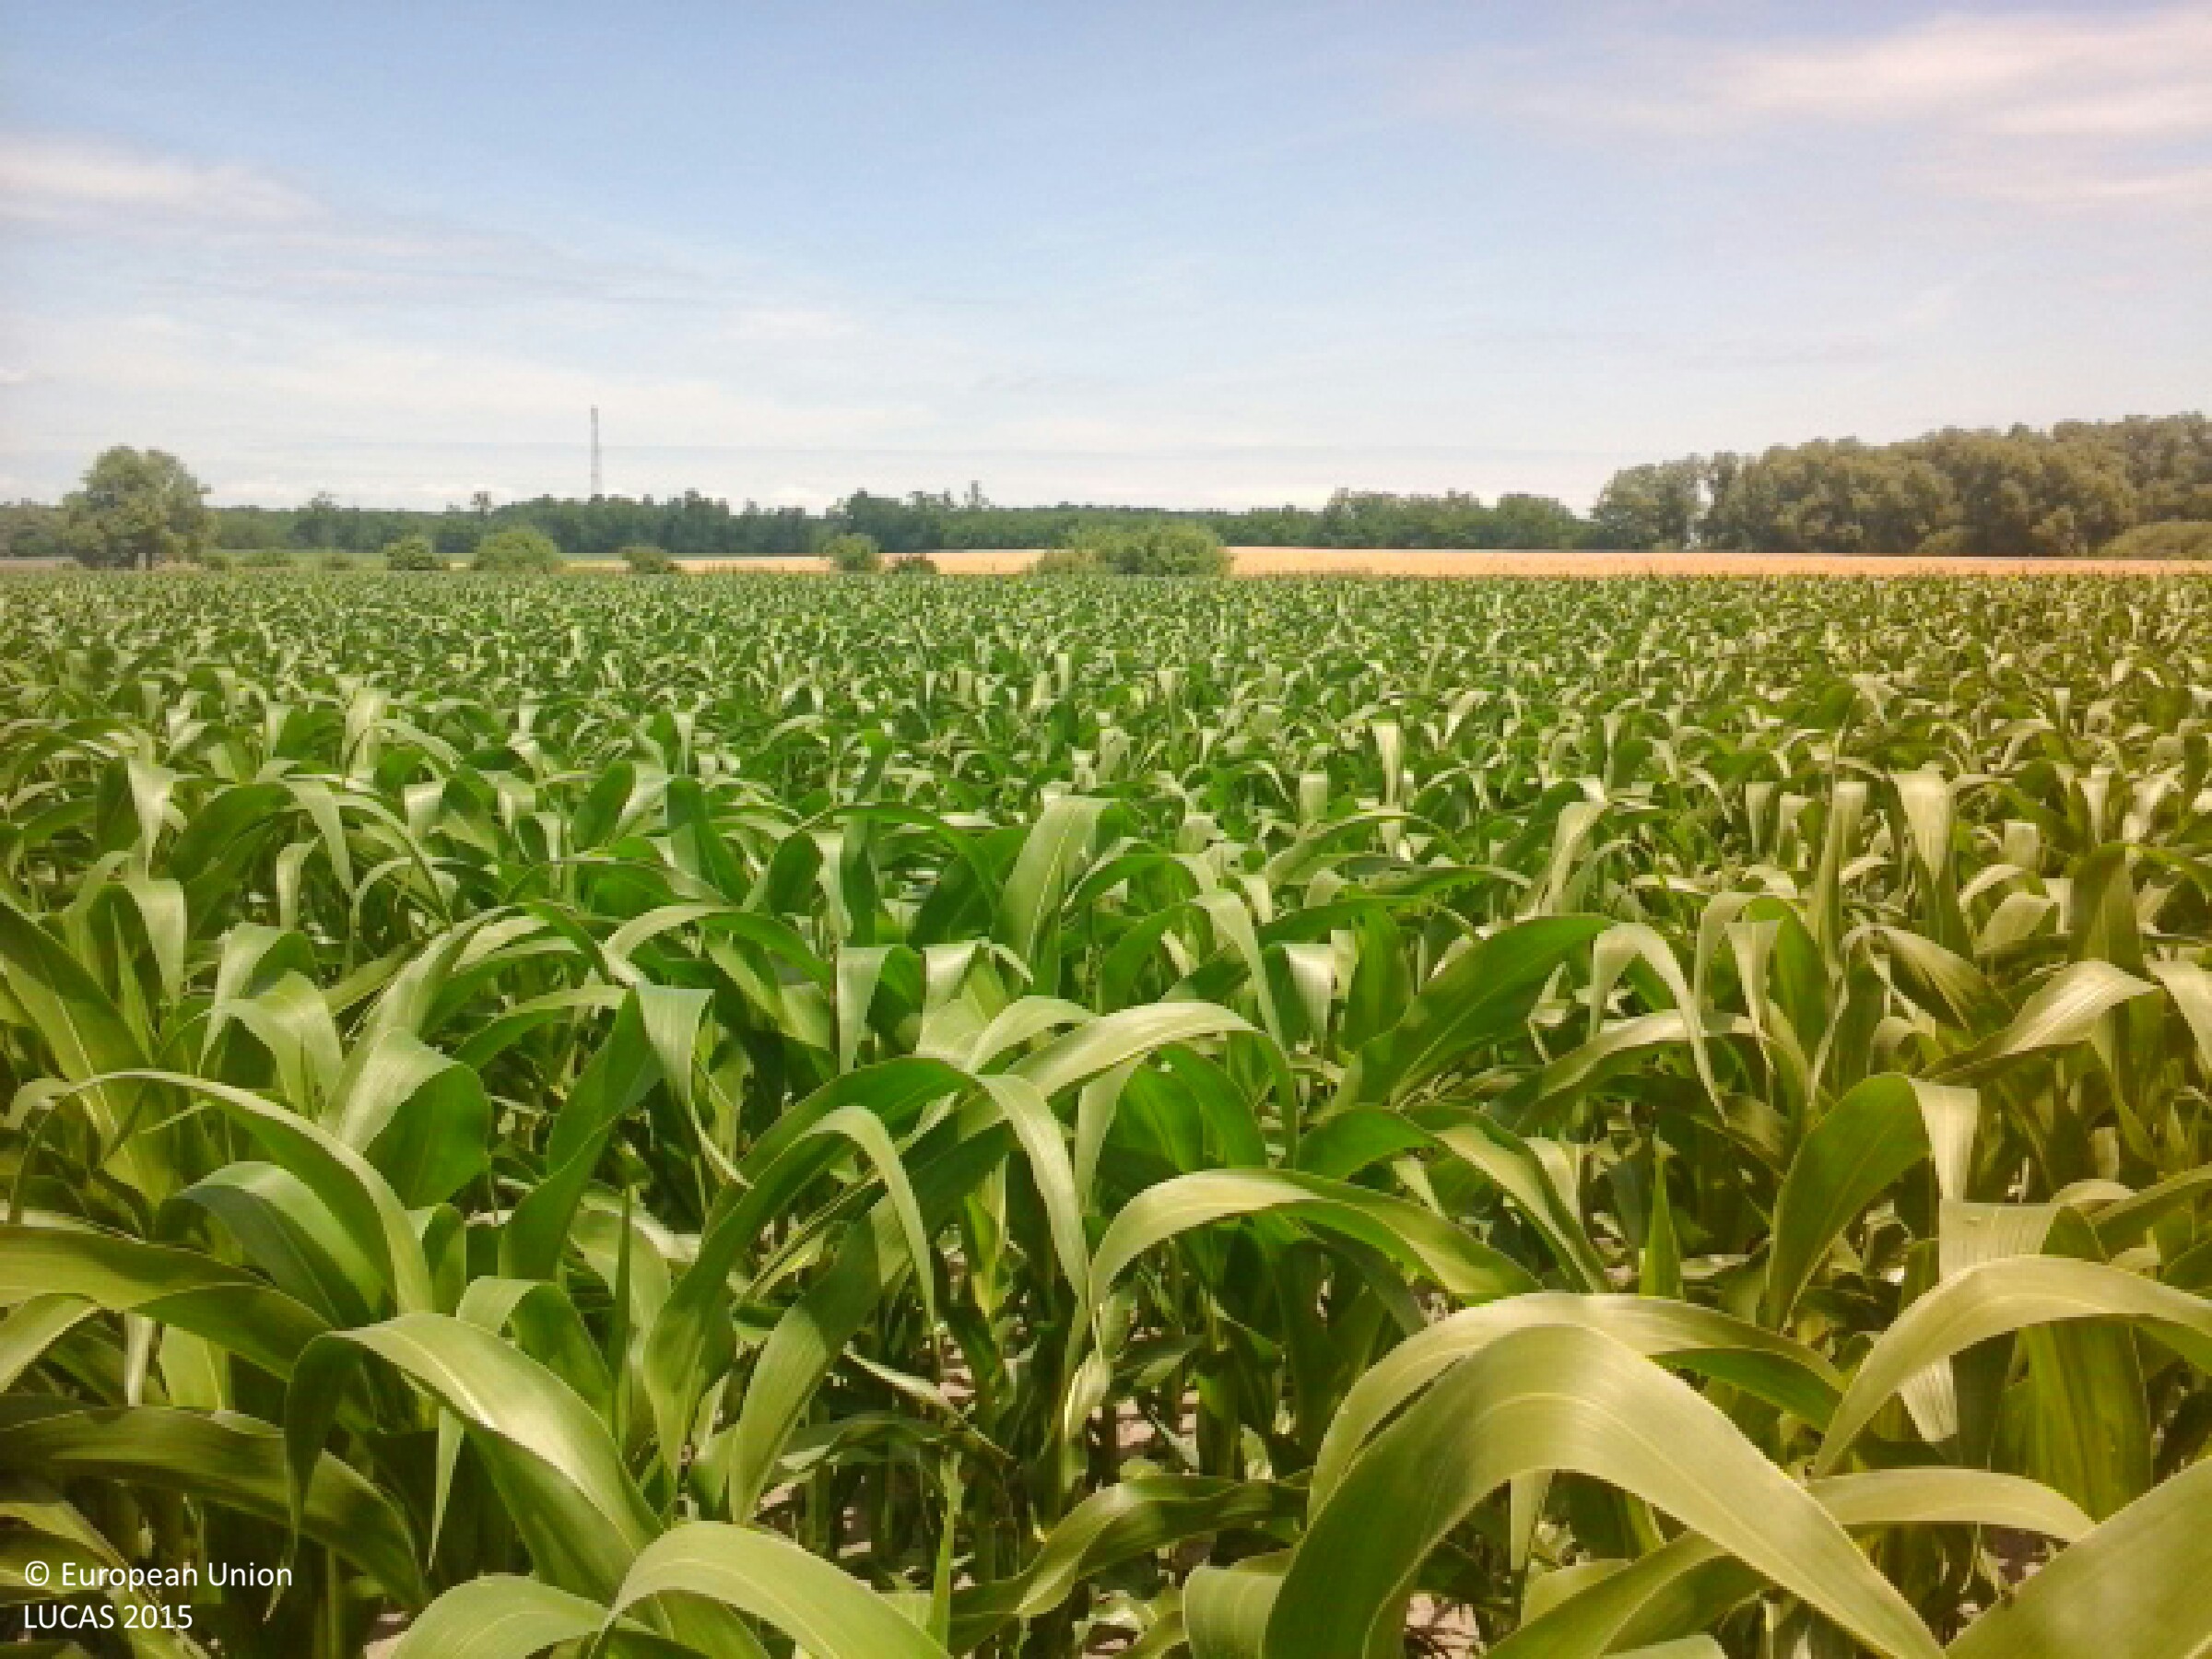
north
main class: Cropland
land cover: Maize
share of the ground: > 75 %
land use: Agriculture (excluding fallow land and kitchen gardens)
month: June
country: HU
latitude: 48.0083
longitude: 21.9412
